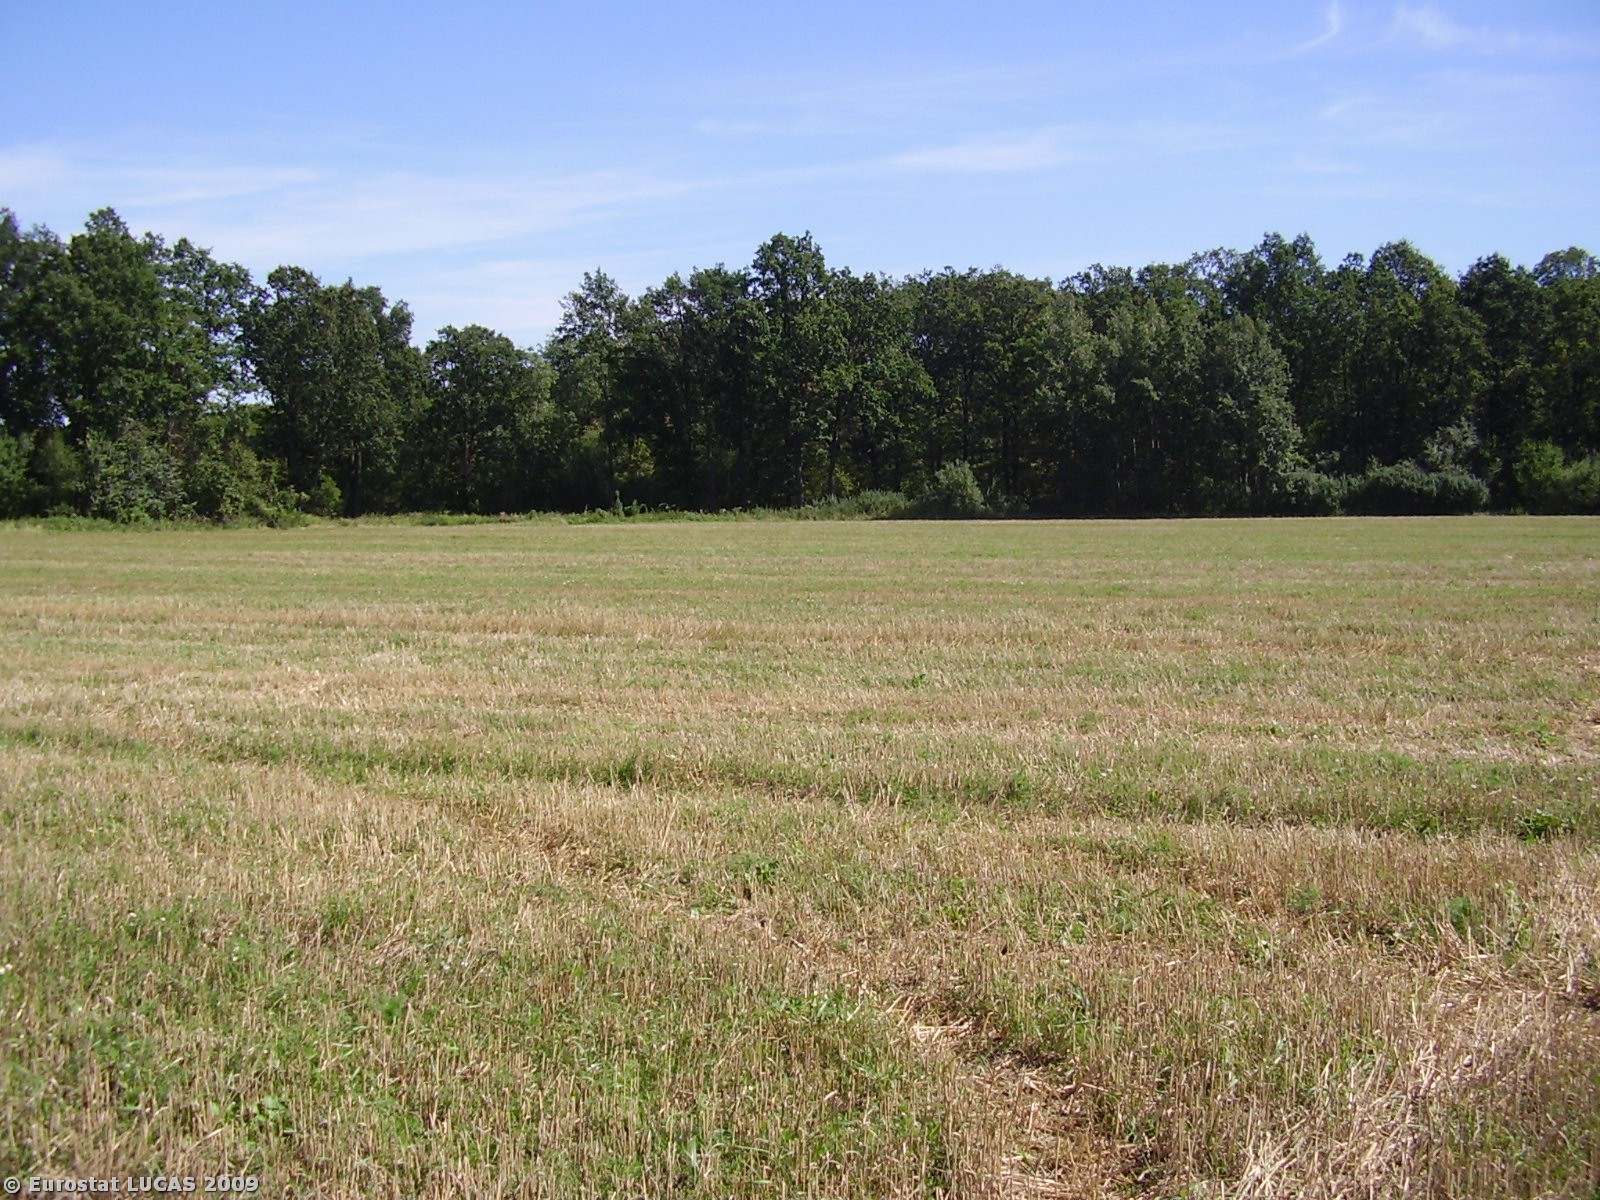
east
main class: Cropland
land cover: Common wheat
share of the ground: < 10 %
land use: Agriculture (excluding fallow land and kitchen gardens)
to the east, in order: Common wheat; Ditches and canals; Lines of trees; Tracks; Broadleaved woodland
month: August
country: PL
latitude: 51.4062
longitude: 16.8090
